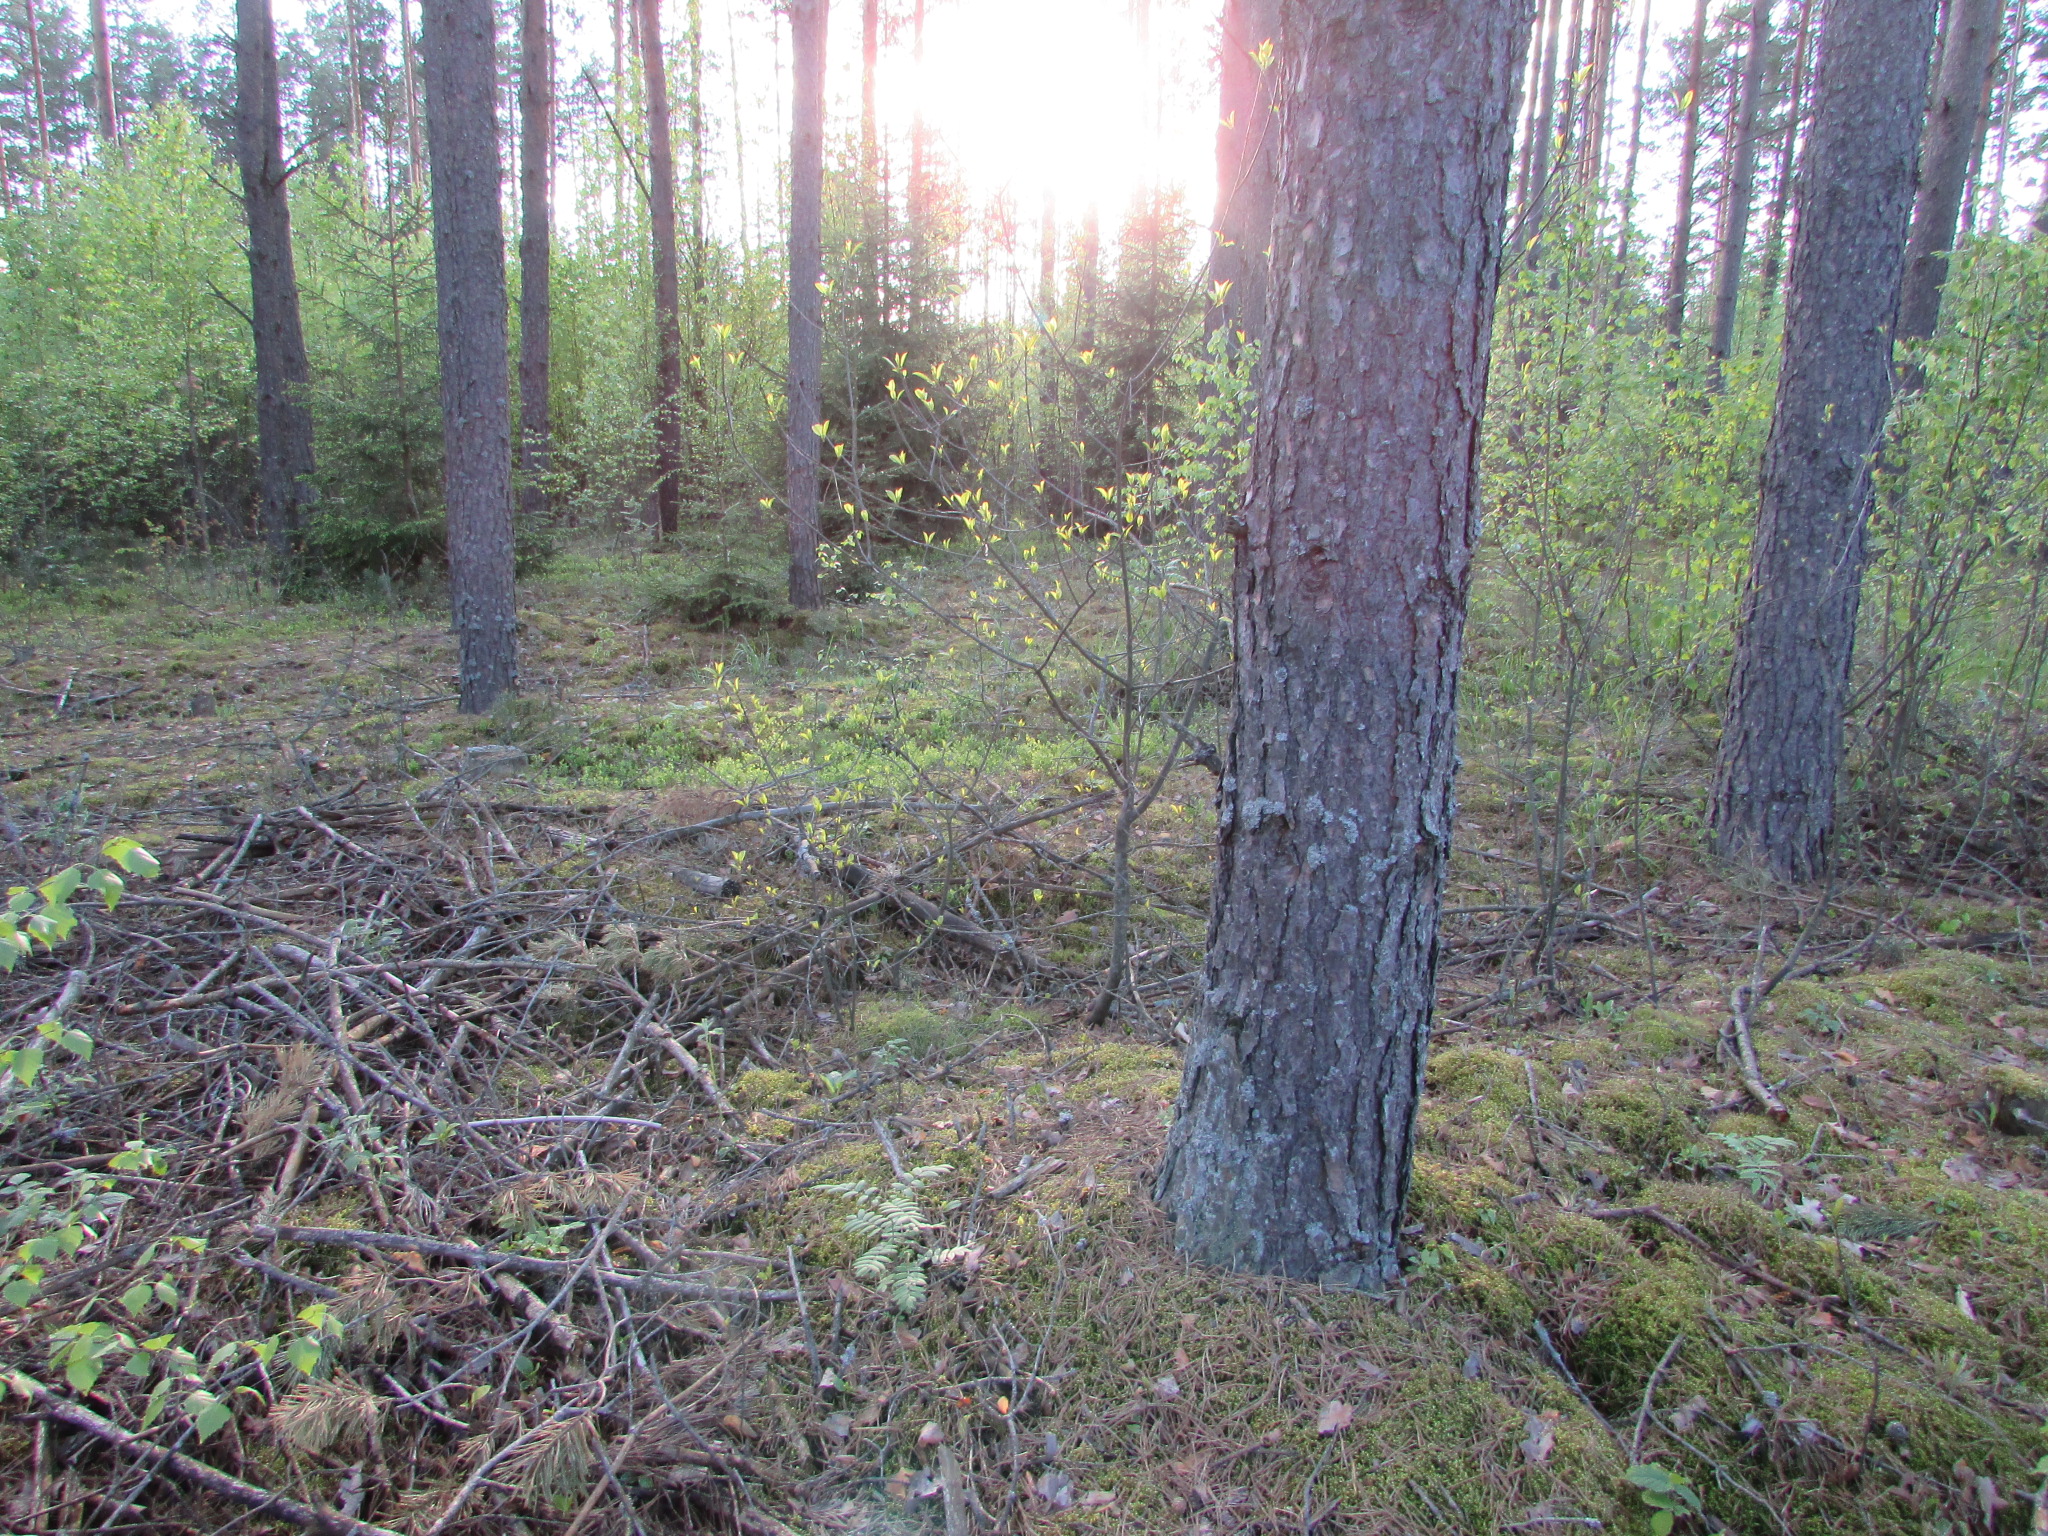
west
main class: Woodland
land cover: Pine dominated coniferous woodland
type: hemiboreal forest and nemoral coniferous forest and mixed broadleaved-coniferous forest
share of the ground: > 75 %
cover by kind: coniferous forest trees 90 %, broadleaved forest trees 10 %
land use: Forestry
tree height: > 5 m
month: May
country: LV
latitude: 56.1749
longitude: 27.1967
